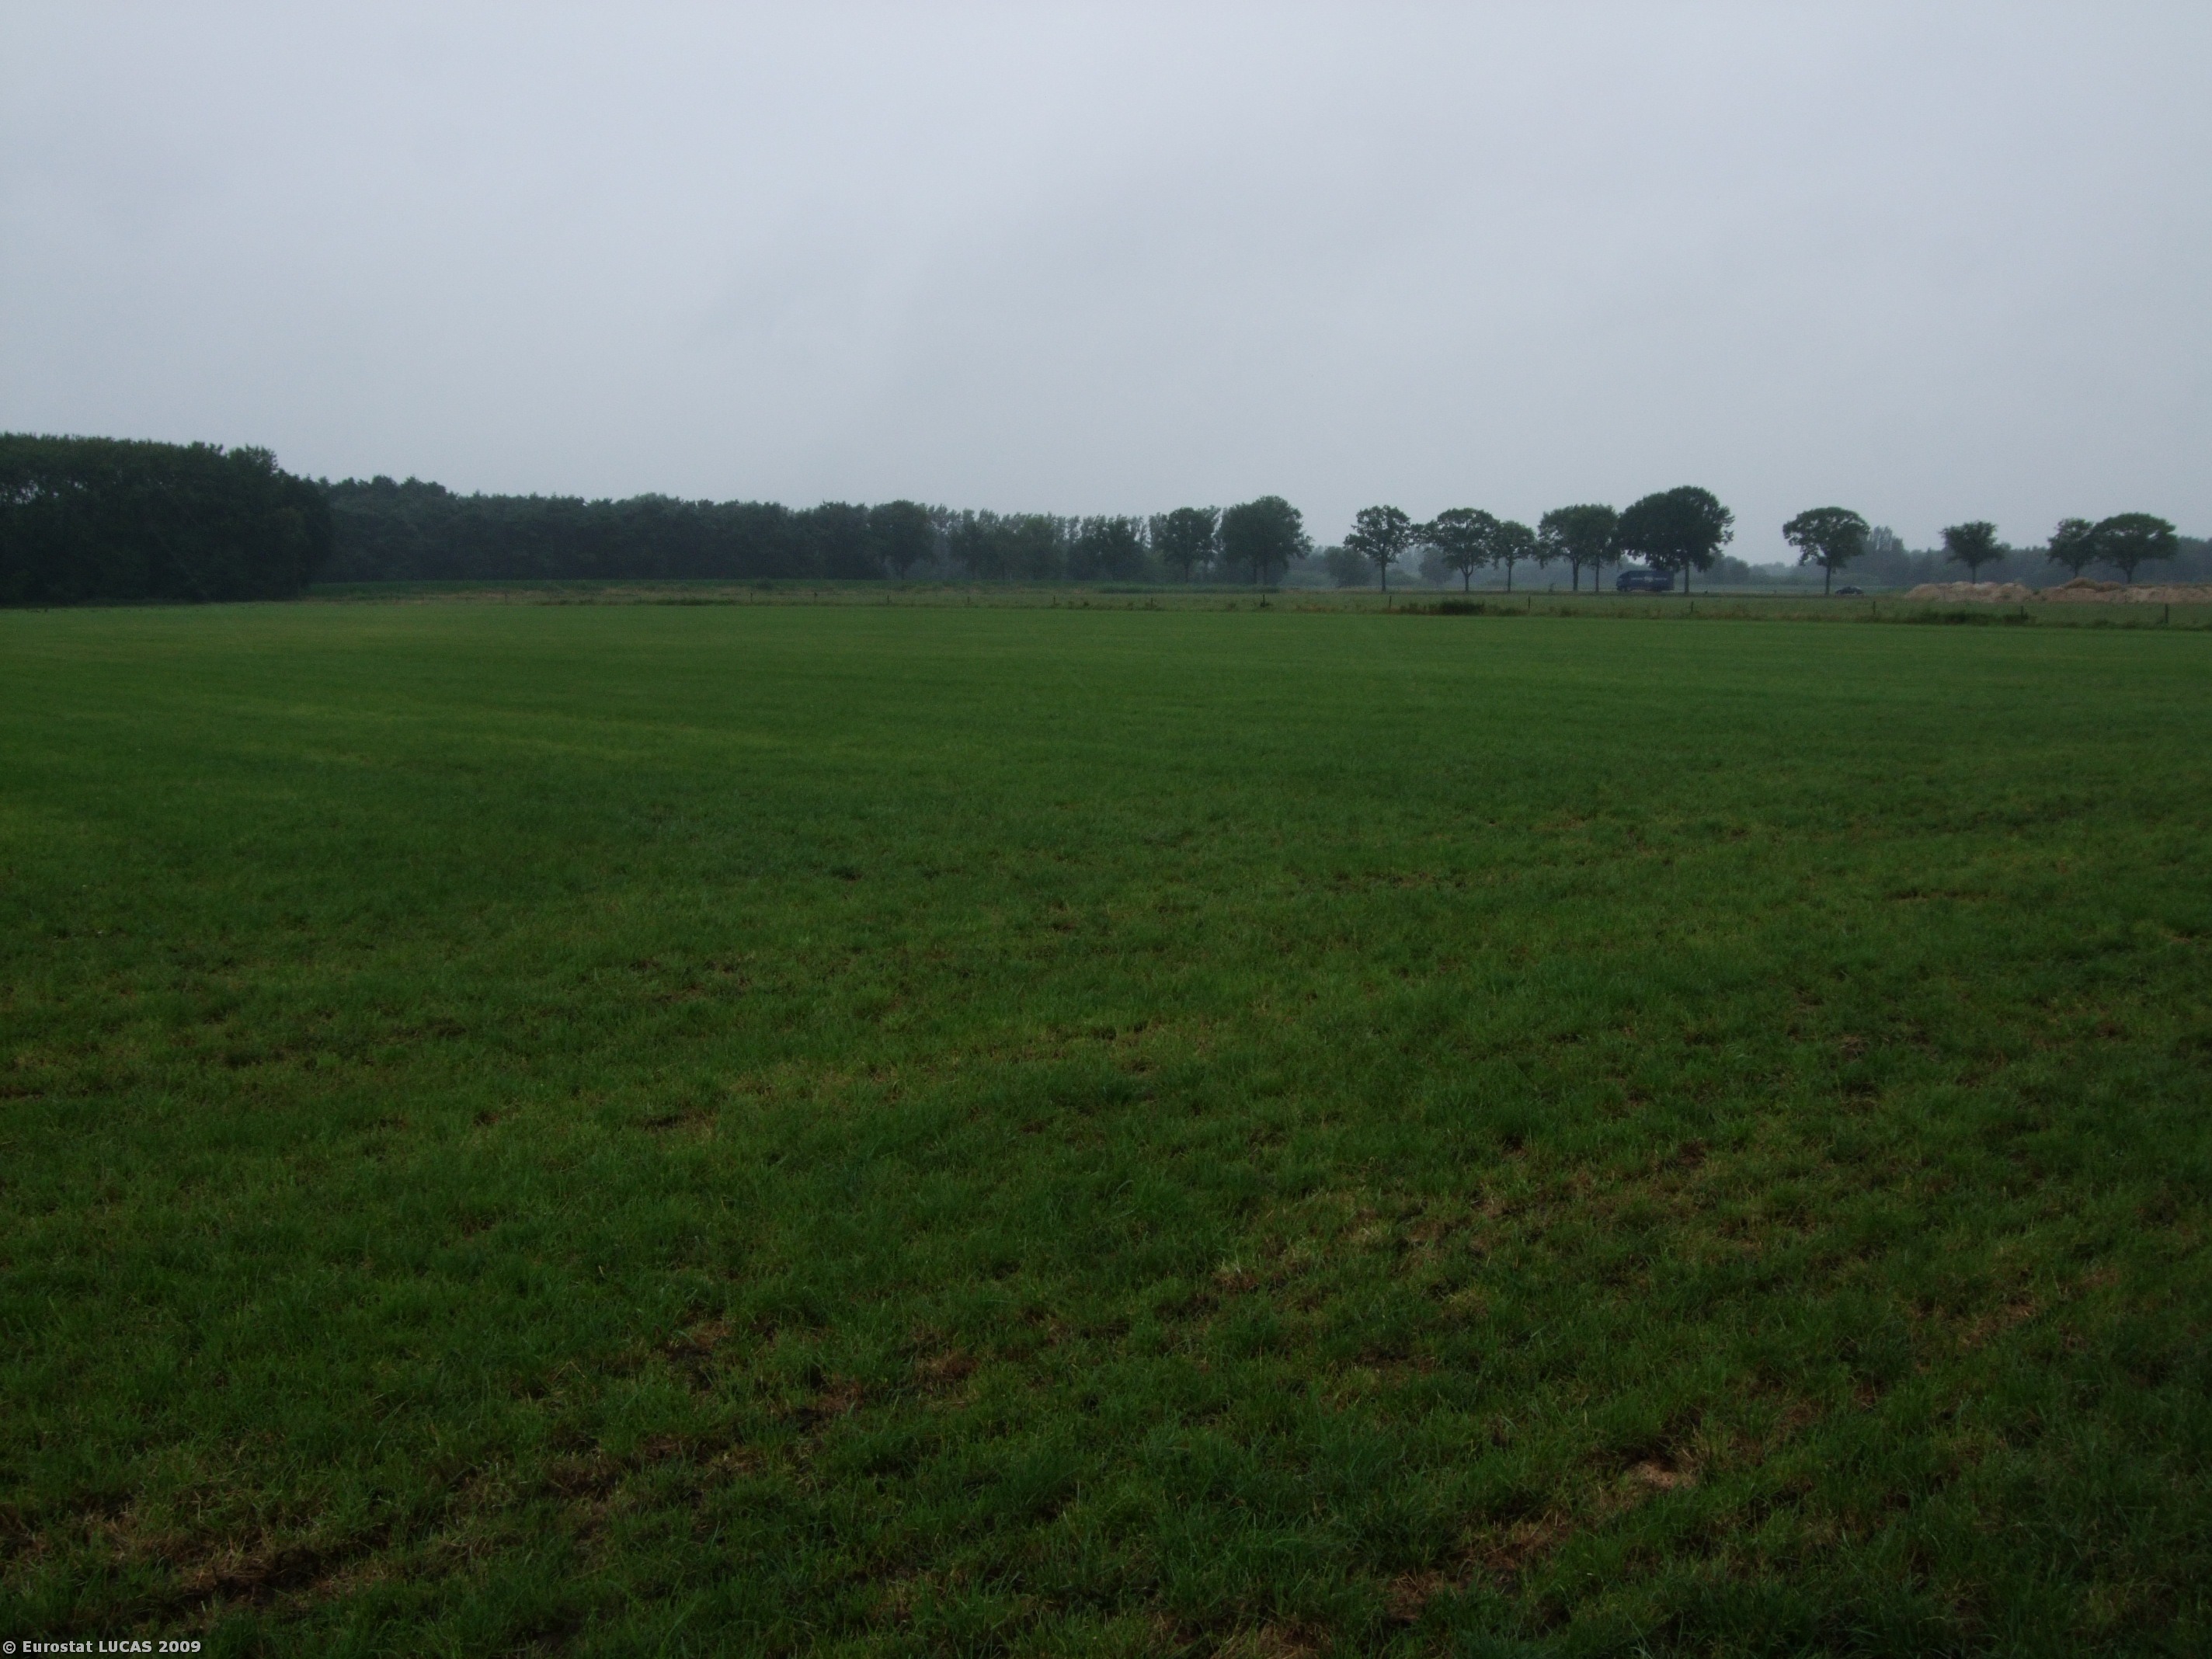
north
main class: Grassland
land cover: Grassland without tree/shrub cover
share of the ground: > 75 %
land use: Agriculture (excluding fallow land and kitchen gardens)
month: July
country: NL
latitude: 51.3099
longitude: 5.7091
